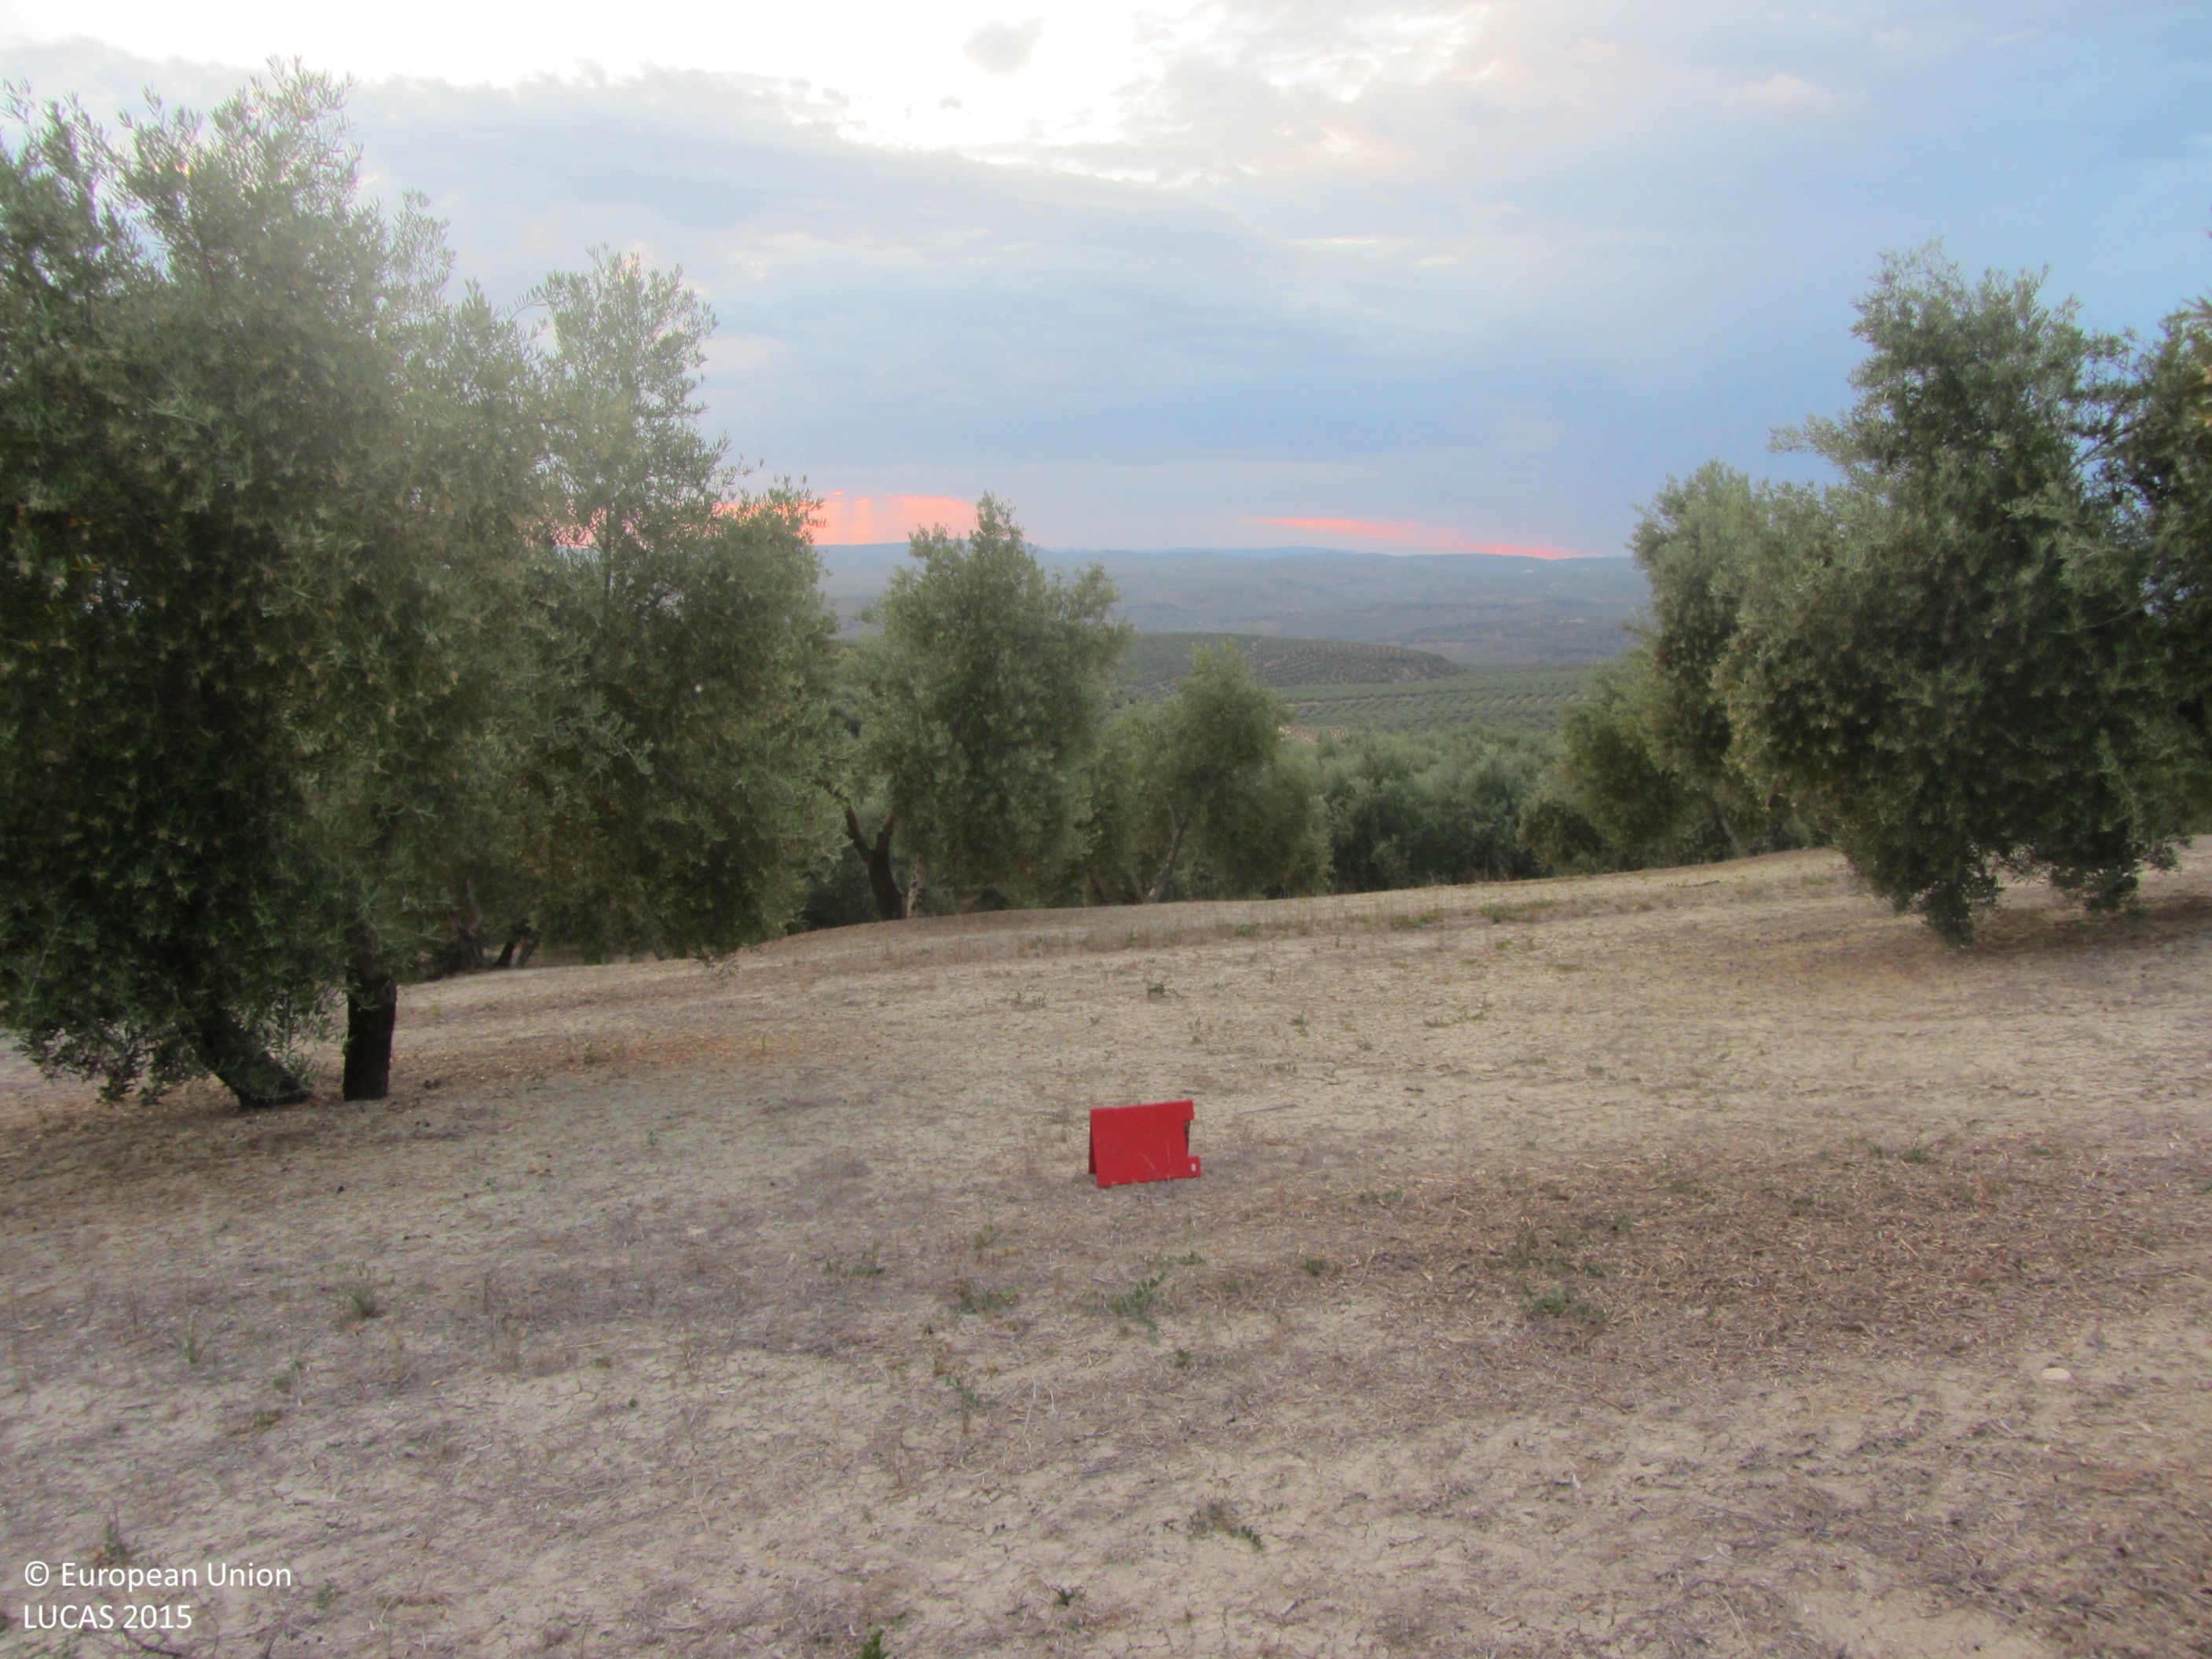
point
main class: Cropland
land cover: Olive groves
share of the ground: 25 - 50 %
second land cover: Other bare soil
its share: > 75 %
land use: Agriculture (excluding fallow land and kitchen gardens)
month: May
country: ES
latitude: 38.1651
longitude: -3.0449
